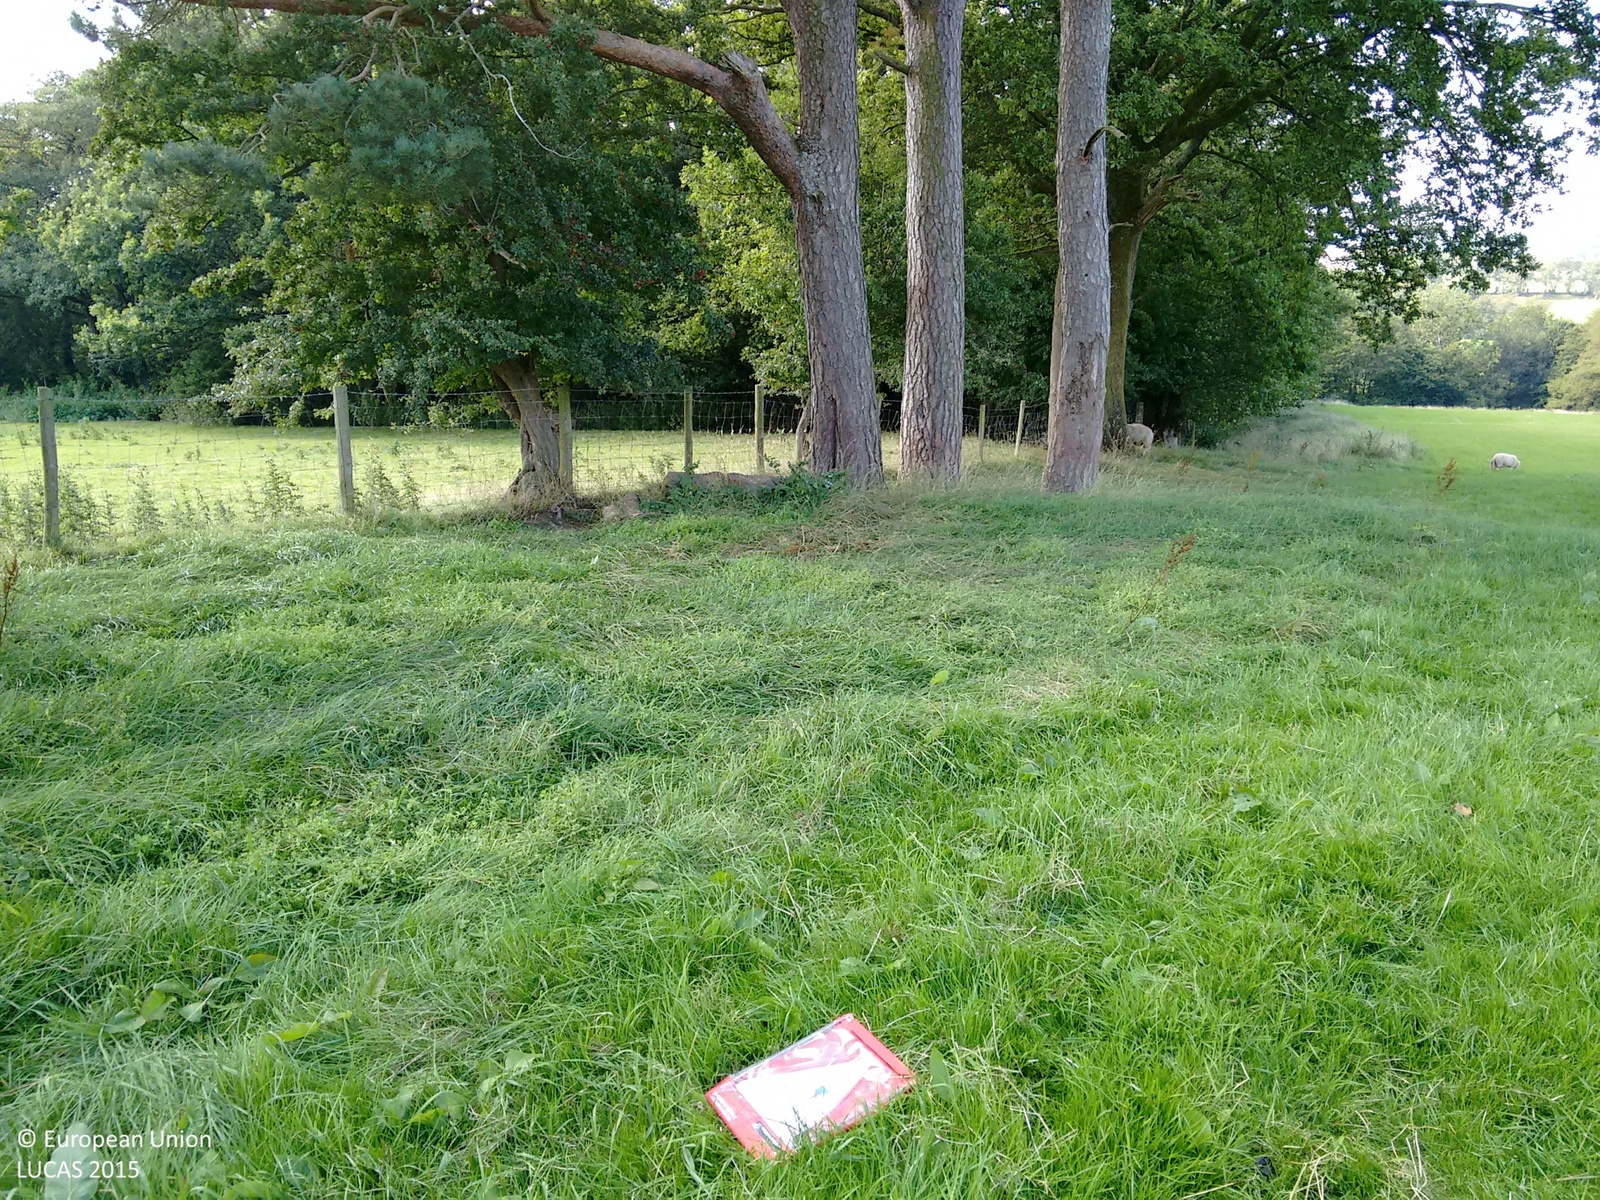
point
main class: Grassland
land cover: Grassland without tree/shrub cover
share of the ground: > 75 %
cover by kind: herbaceous plants 100 %
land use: Agriculture (excluding fallow land and kitchen gardens)
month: September
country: GB
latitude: 51.9181
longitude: -3.4450
